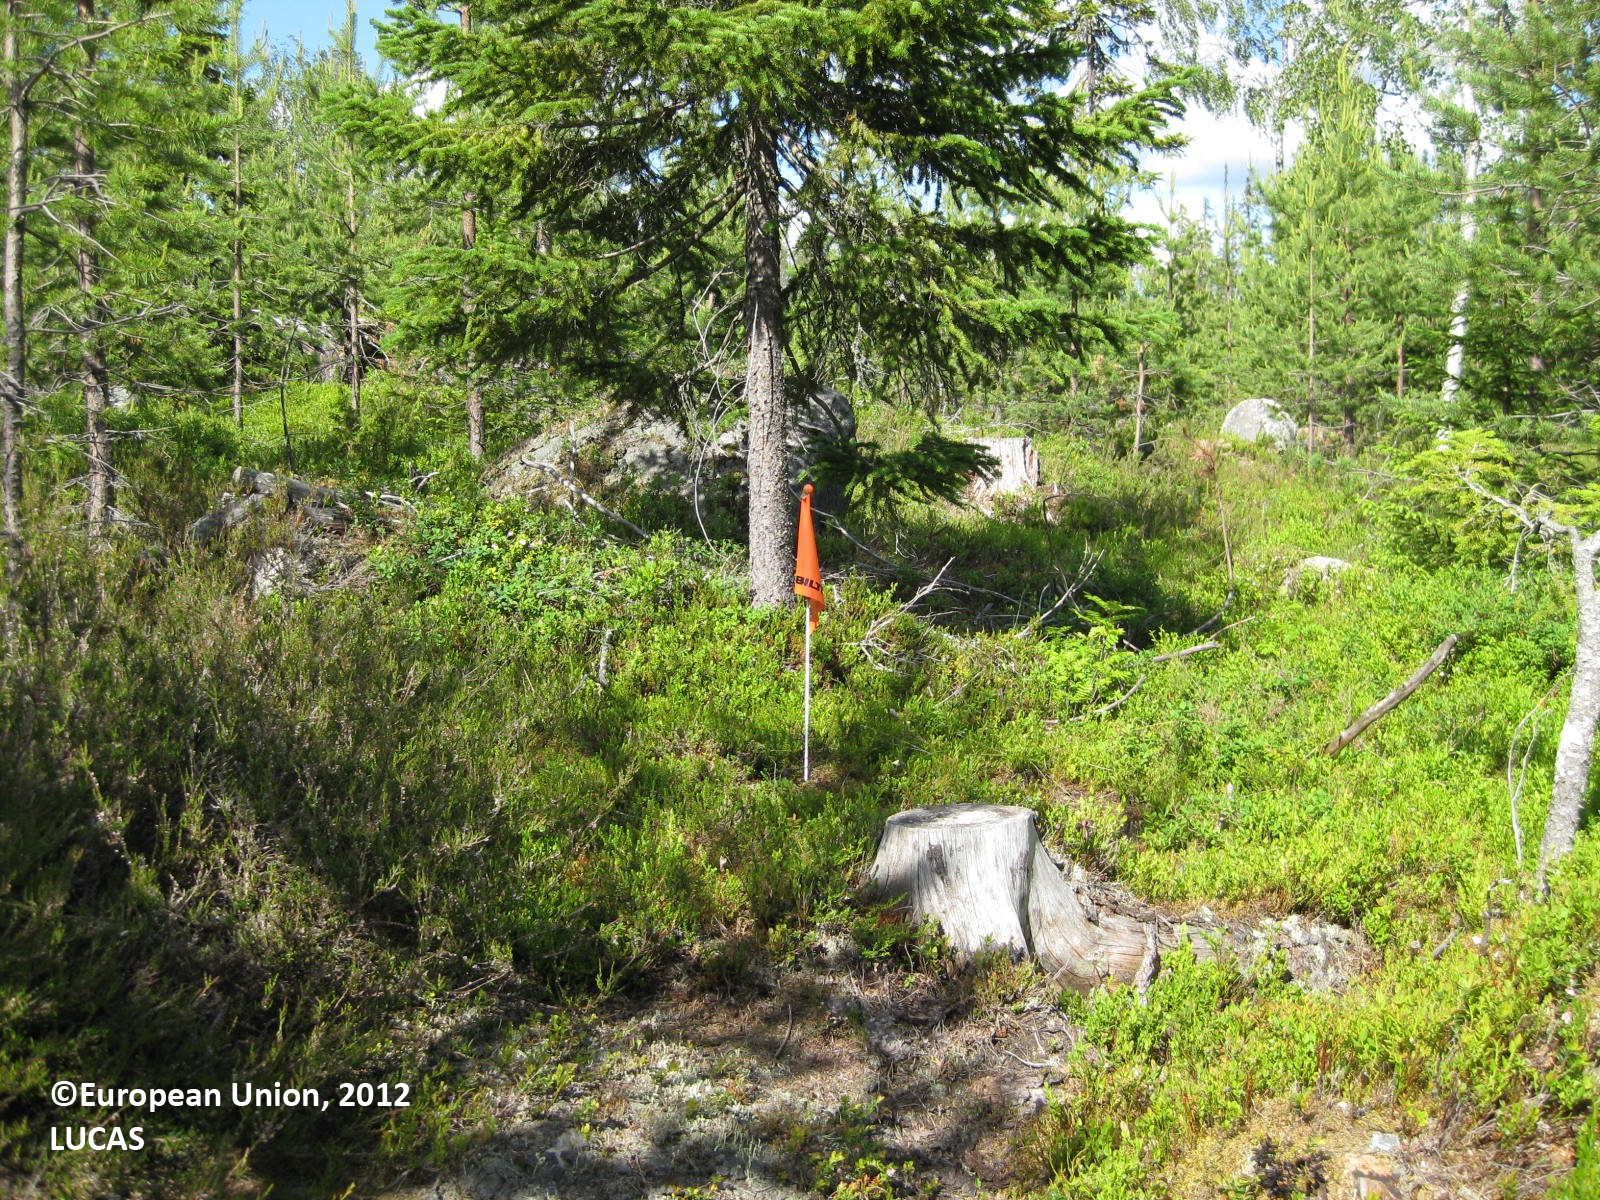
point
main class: Woodland
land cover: Pine dominated coniferous woodland
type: boreal forest
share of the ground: > 75 %
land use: Forestry
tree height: > 5 m
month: July
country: FI
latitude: 65.5962
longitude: 29.4343
